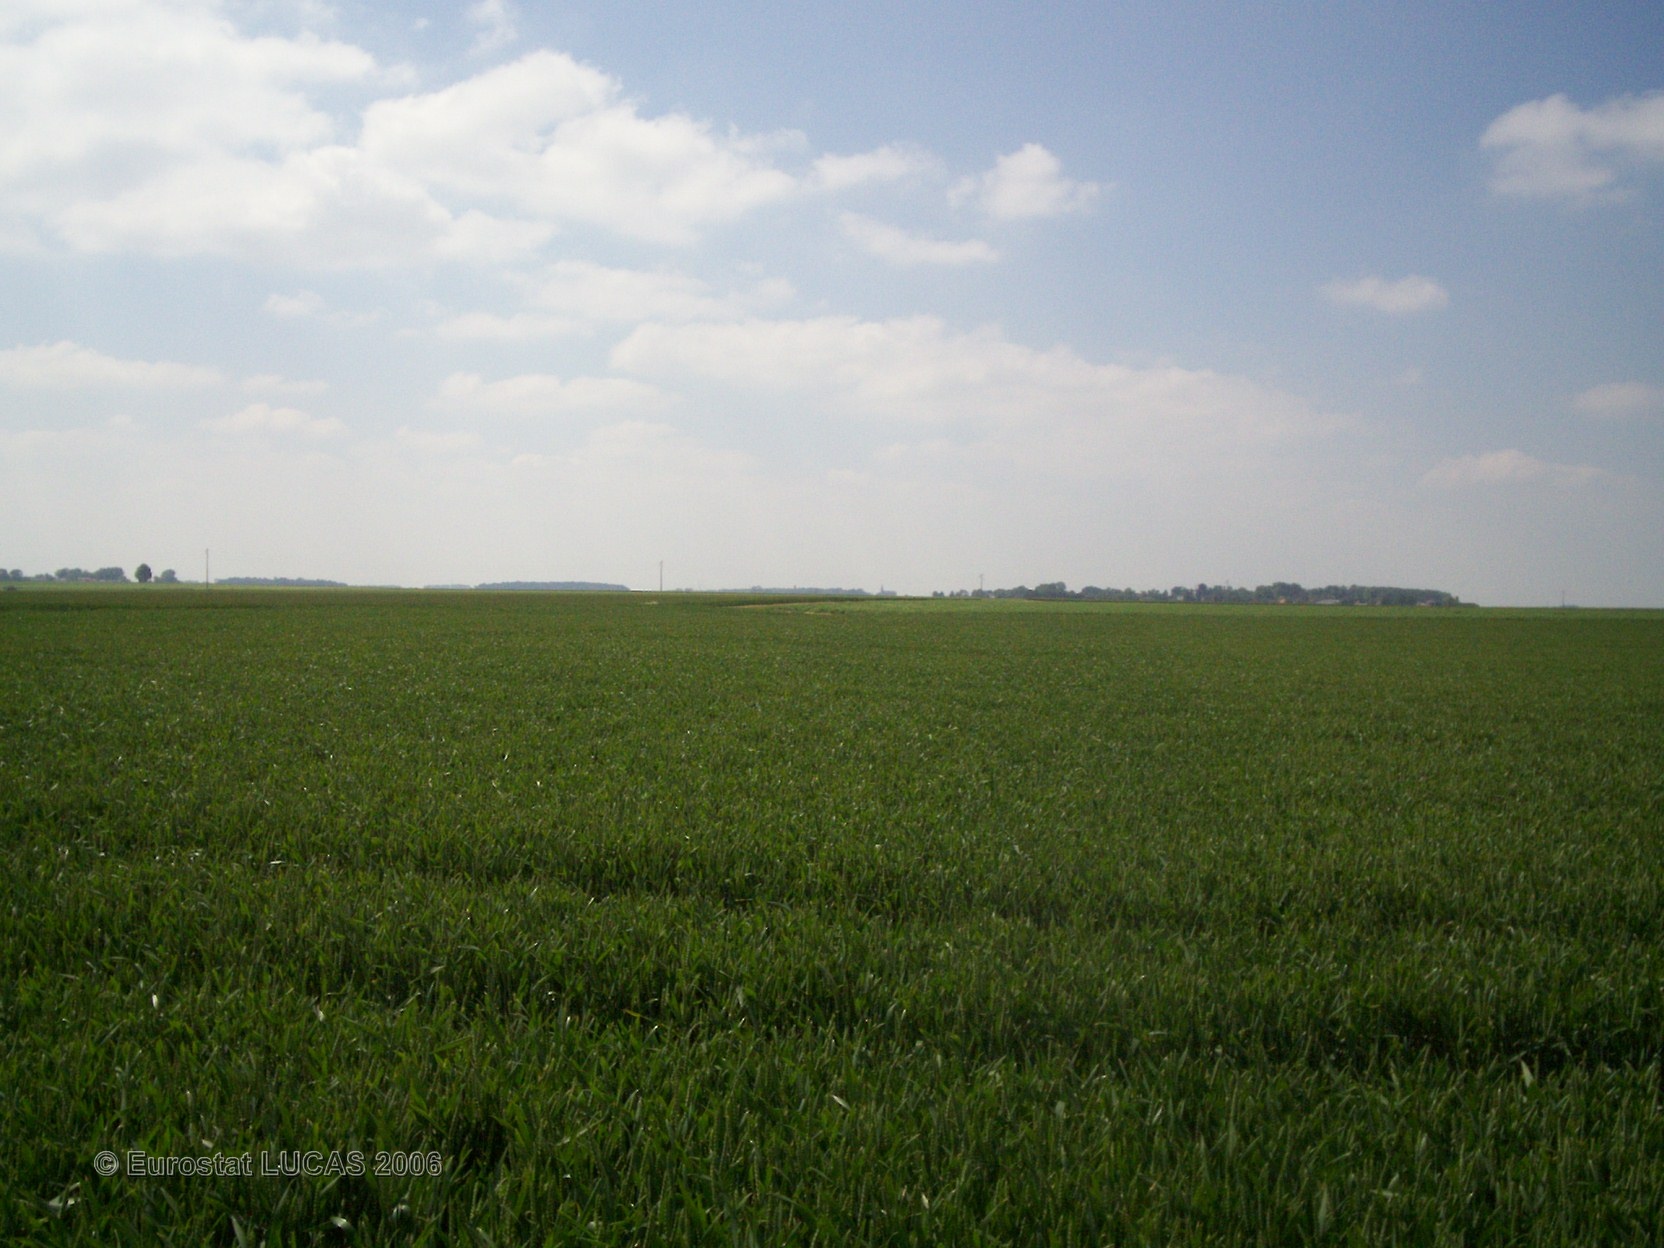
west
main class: Cropland
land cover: Common wheat
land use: Agriculture (excluding fallow land and kitchen gardens)
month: June
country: FR
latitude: 49.7695
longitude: 2.6994
